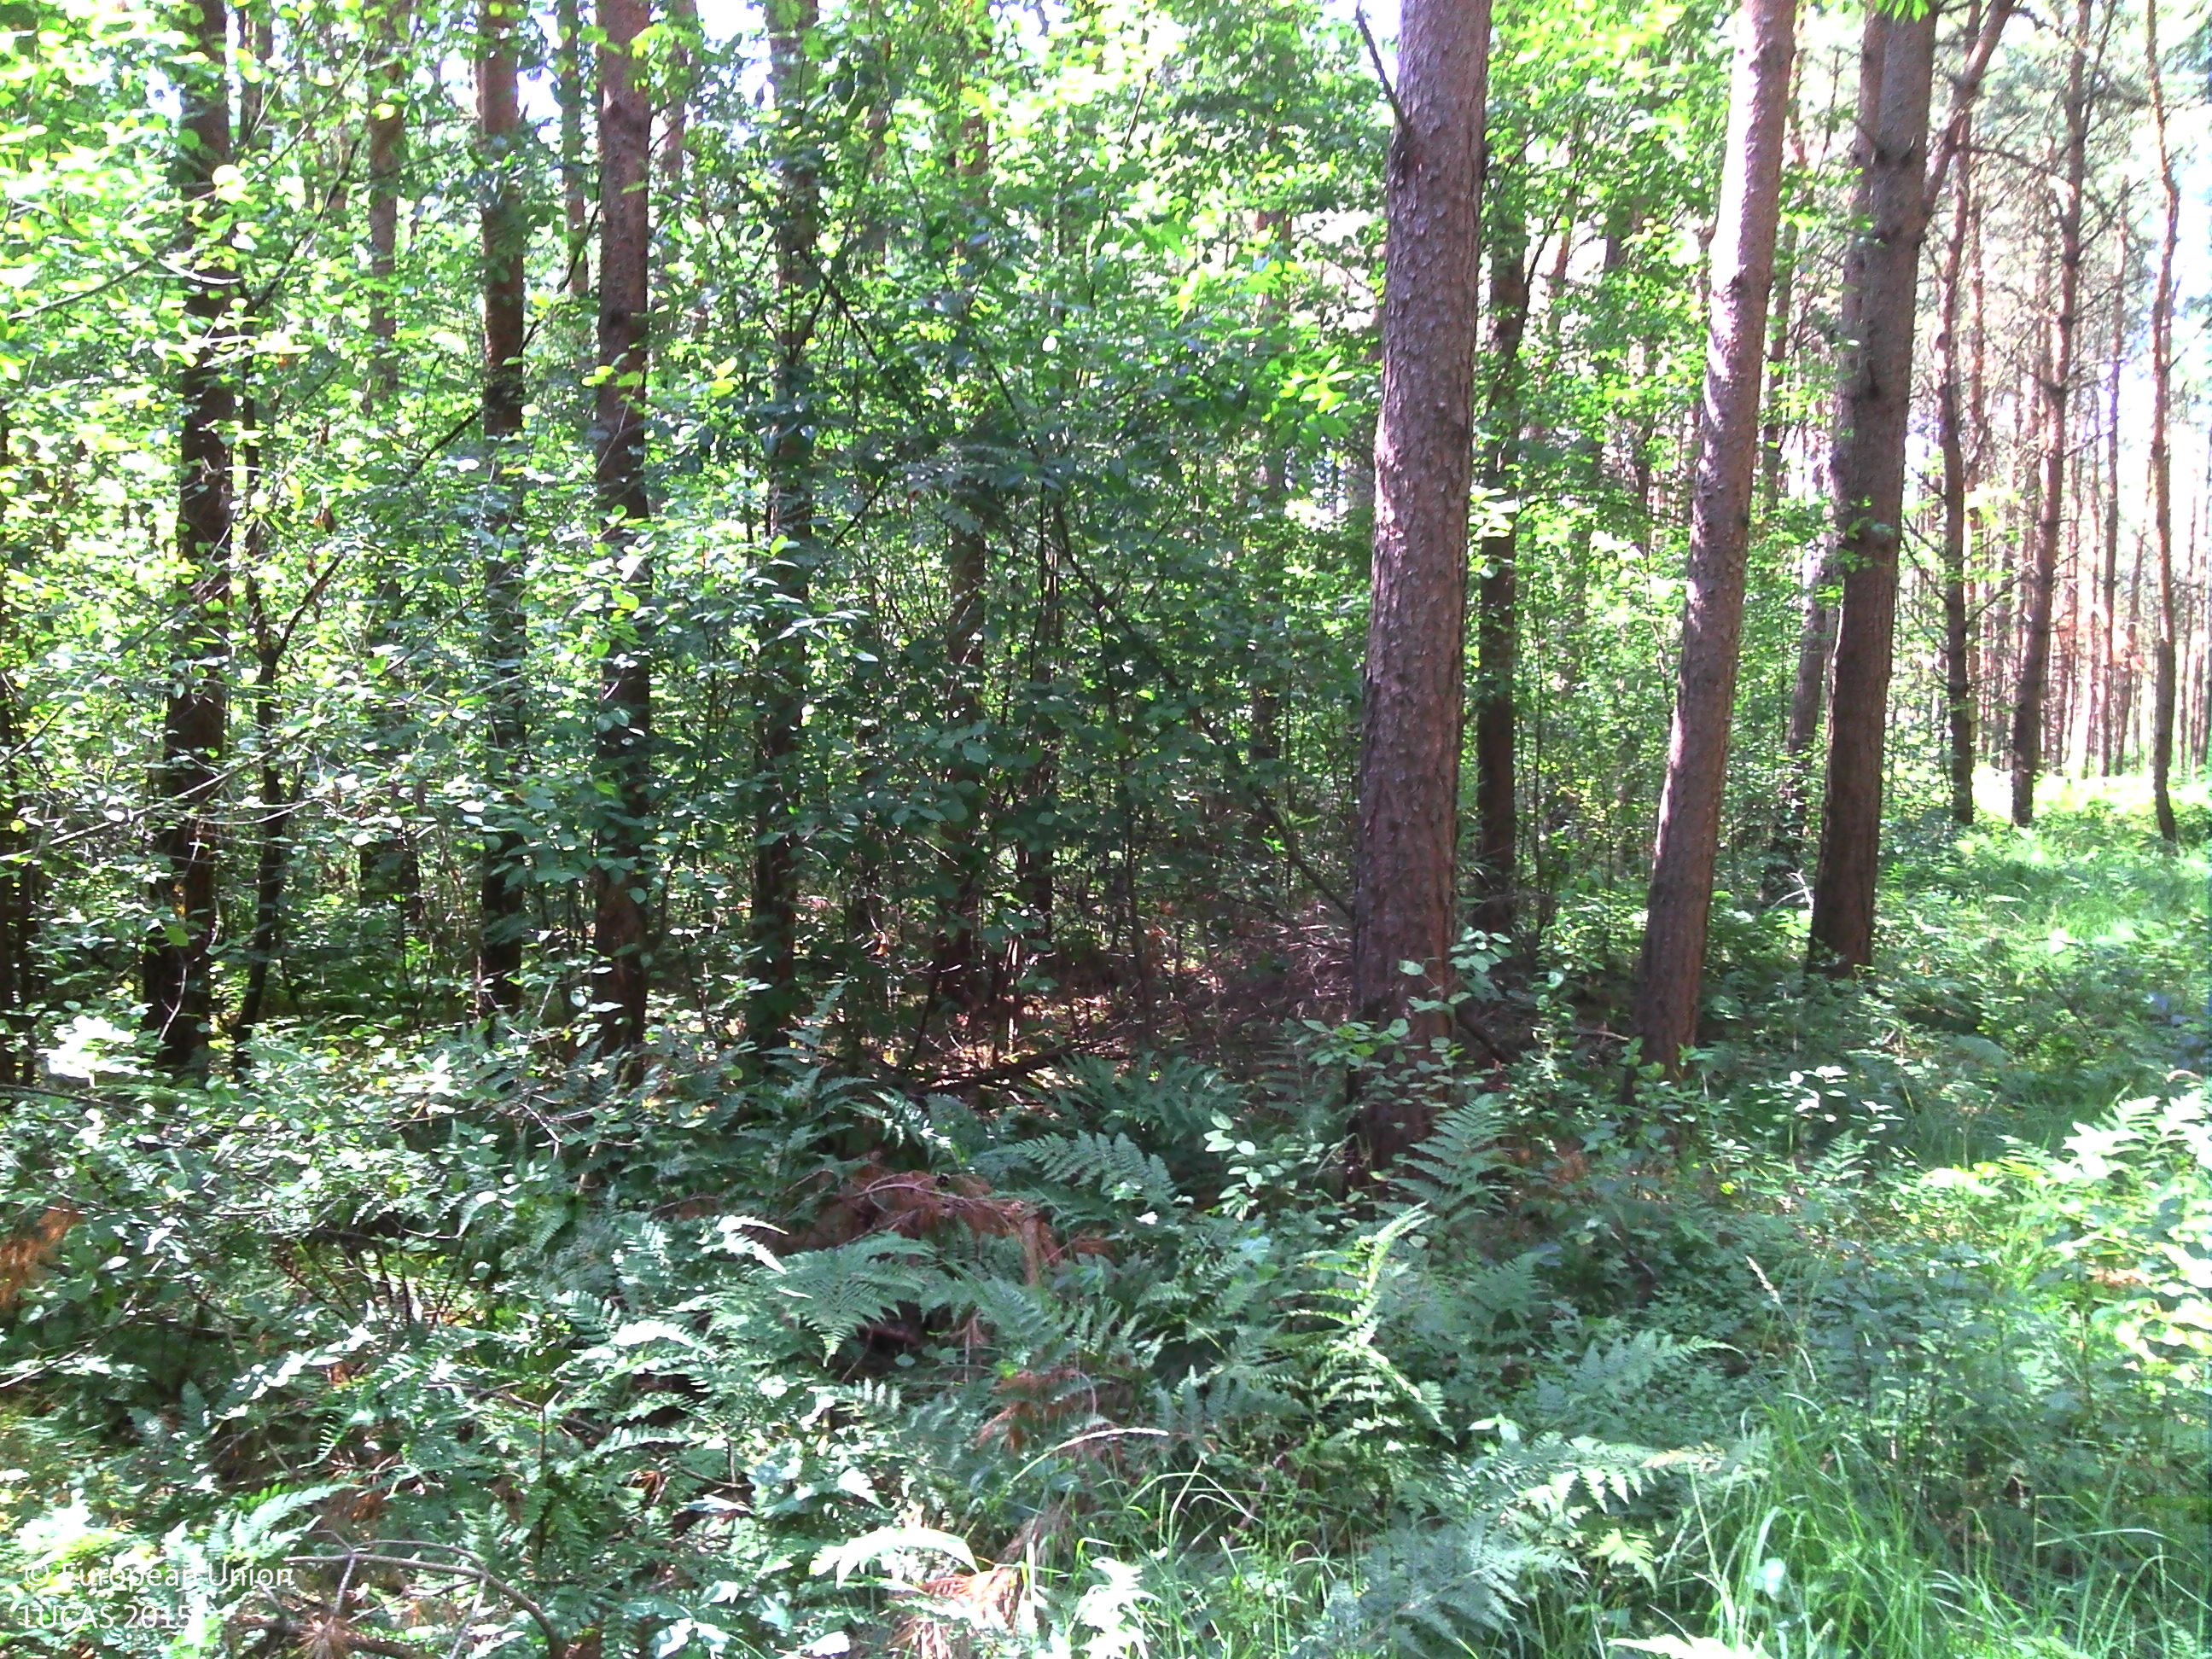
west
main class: Woodland
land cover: Pine dominated mixed woodland
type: exotic forest
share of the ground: > 75 %
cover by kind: coniferous forest trees 70 %, broadleaved forest trees 30 %
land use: Forestry
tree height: > 5 m
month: August
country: BE
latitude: 51.2126
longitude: 5.5175
